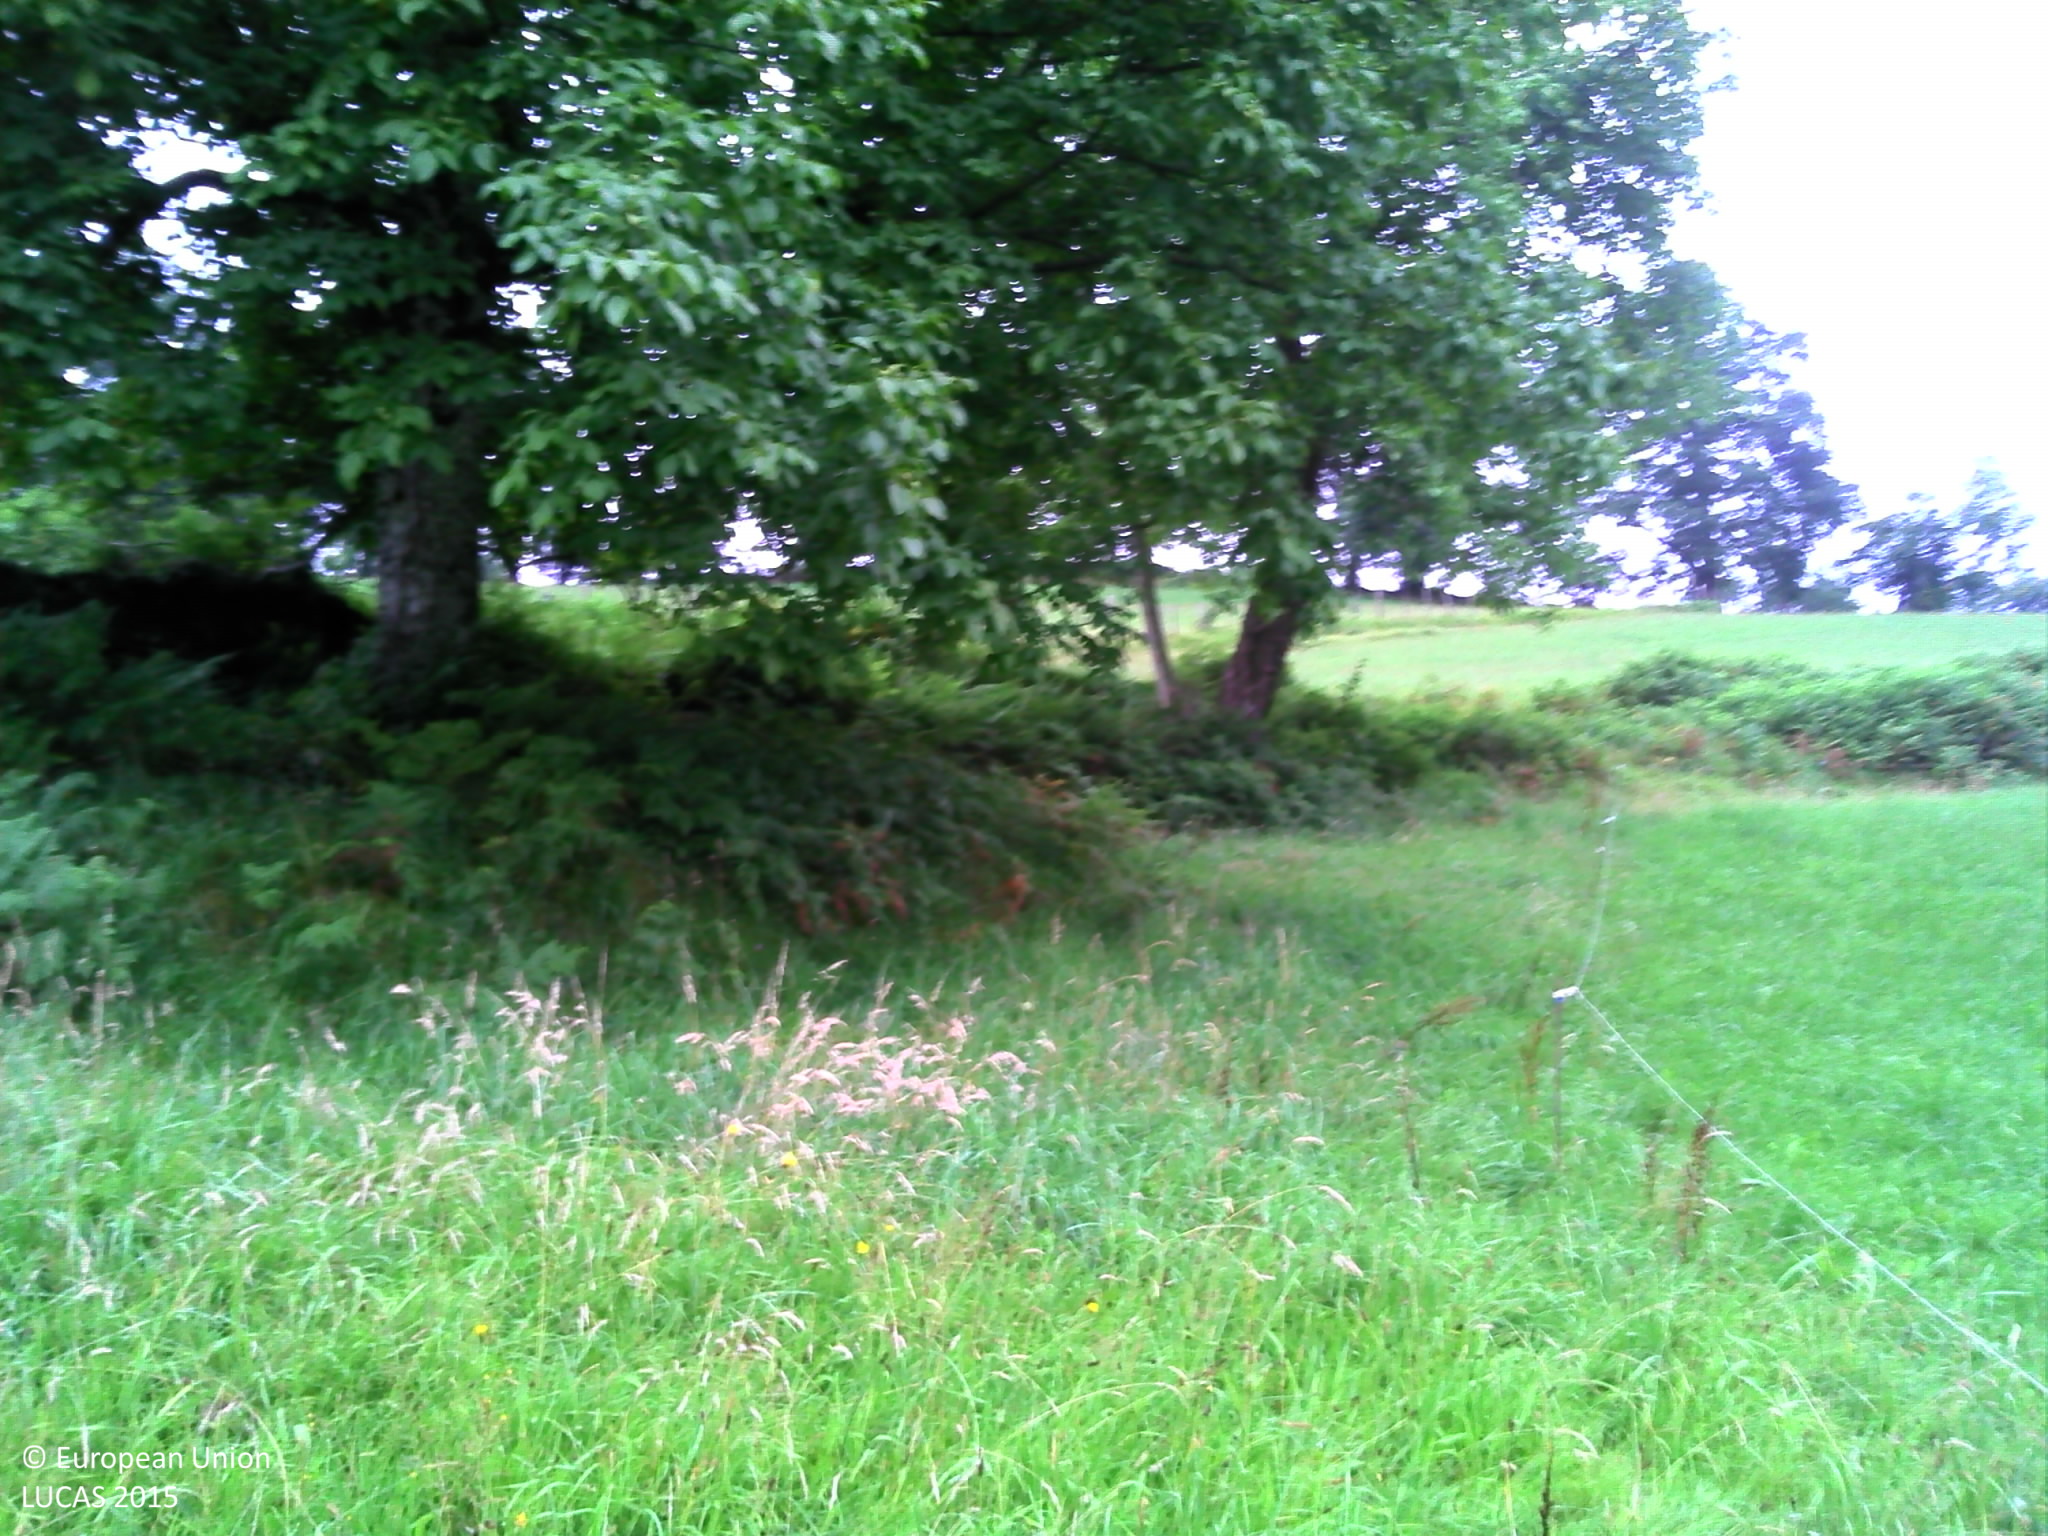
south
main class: Grassland
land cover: Grassland without tree/shrub cover
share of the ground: > 75 %
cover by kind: herbaceous plants 100 %
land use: Agriculture (excluding fallow land and kitchen gardens)
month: July
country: FR
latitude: 43.1210
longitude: -0.3667
